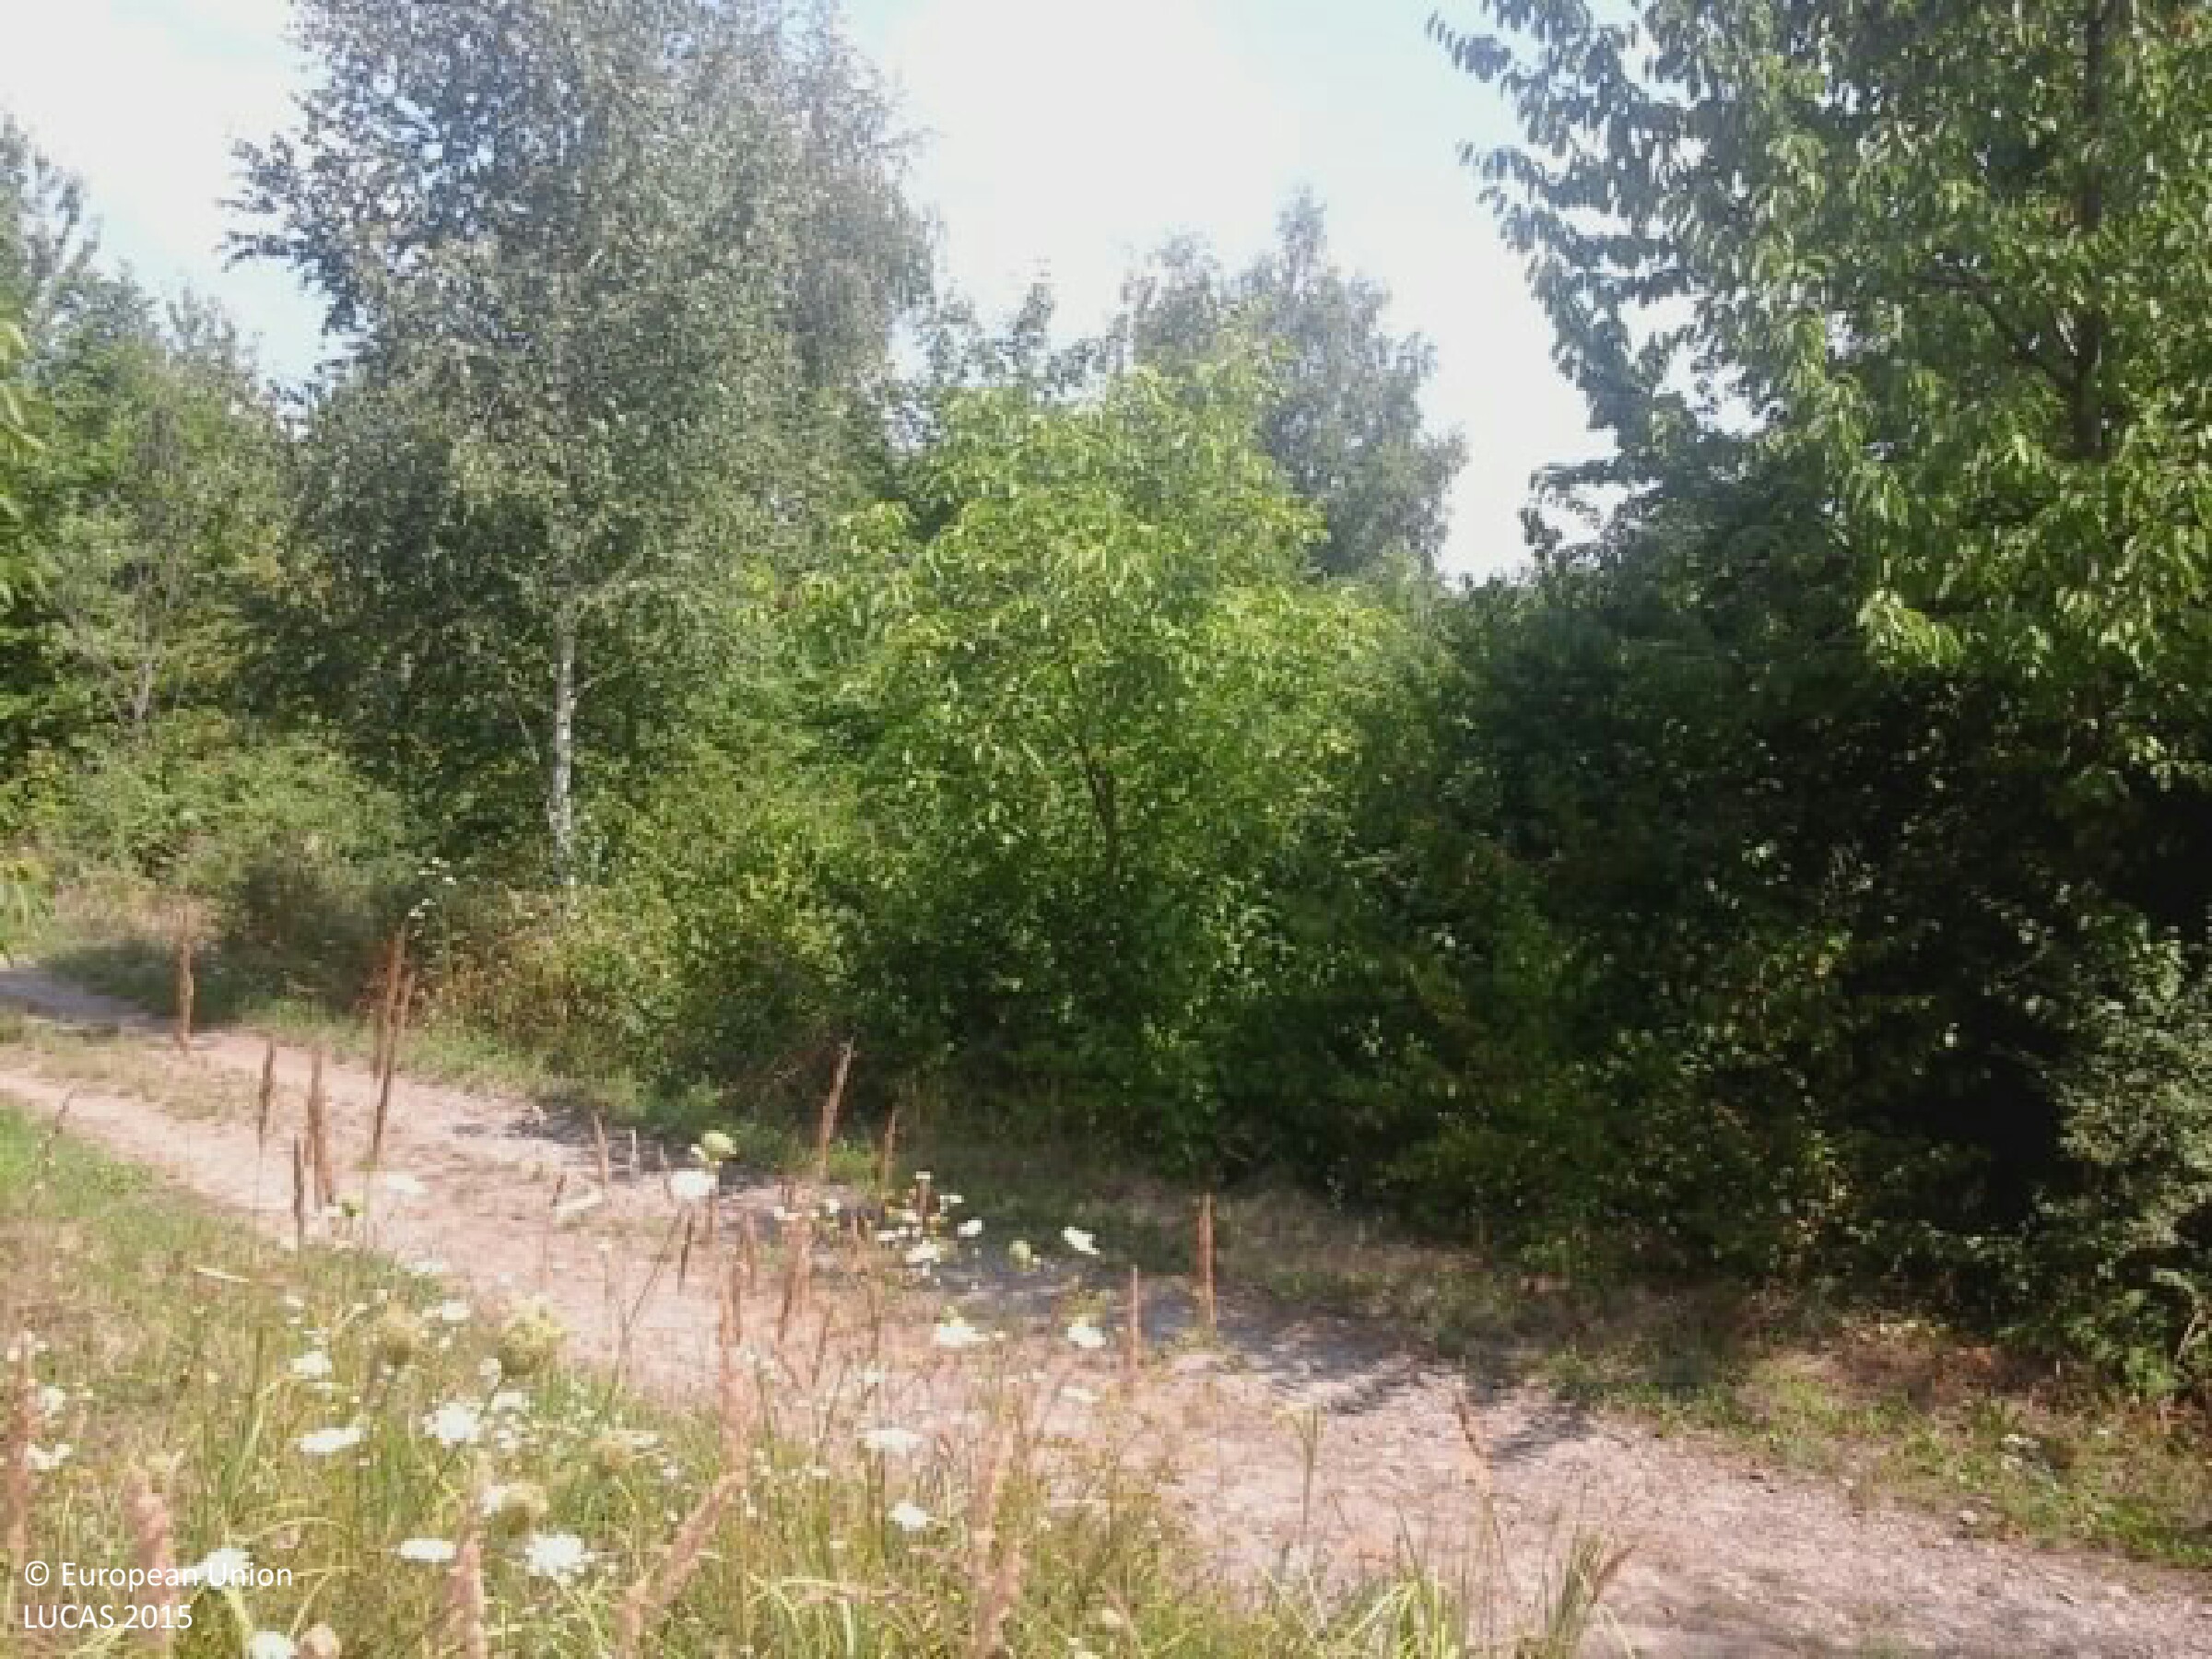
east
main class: Grassland
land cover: Grassland with sparse tree/shrub cover
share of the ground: > 75 %
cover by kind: herbaceous plants 85 %, shrubs 10 %, broadleaved forest trees 5 %
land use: Agriculture (excluding fallow land and kitchen gardens)
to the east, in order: Grassland with sparse tree/shrub cover; Tracks; Grass margins; Abandoned hedges; Broadleaved woodland; Grass margins; Electric lines; Grass margins; Broadleaved woodland; Grassland with sparse tree/shrub cover; Broadleaved woodland; Abandoned hedges; Tracks; Grass margins; Electric lines; Grass margins; Broadleaved woodland
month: August
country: HU
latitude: 46.1961
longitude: 18.2361
